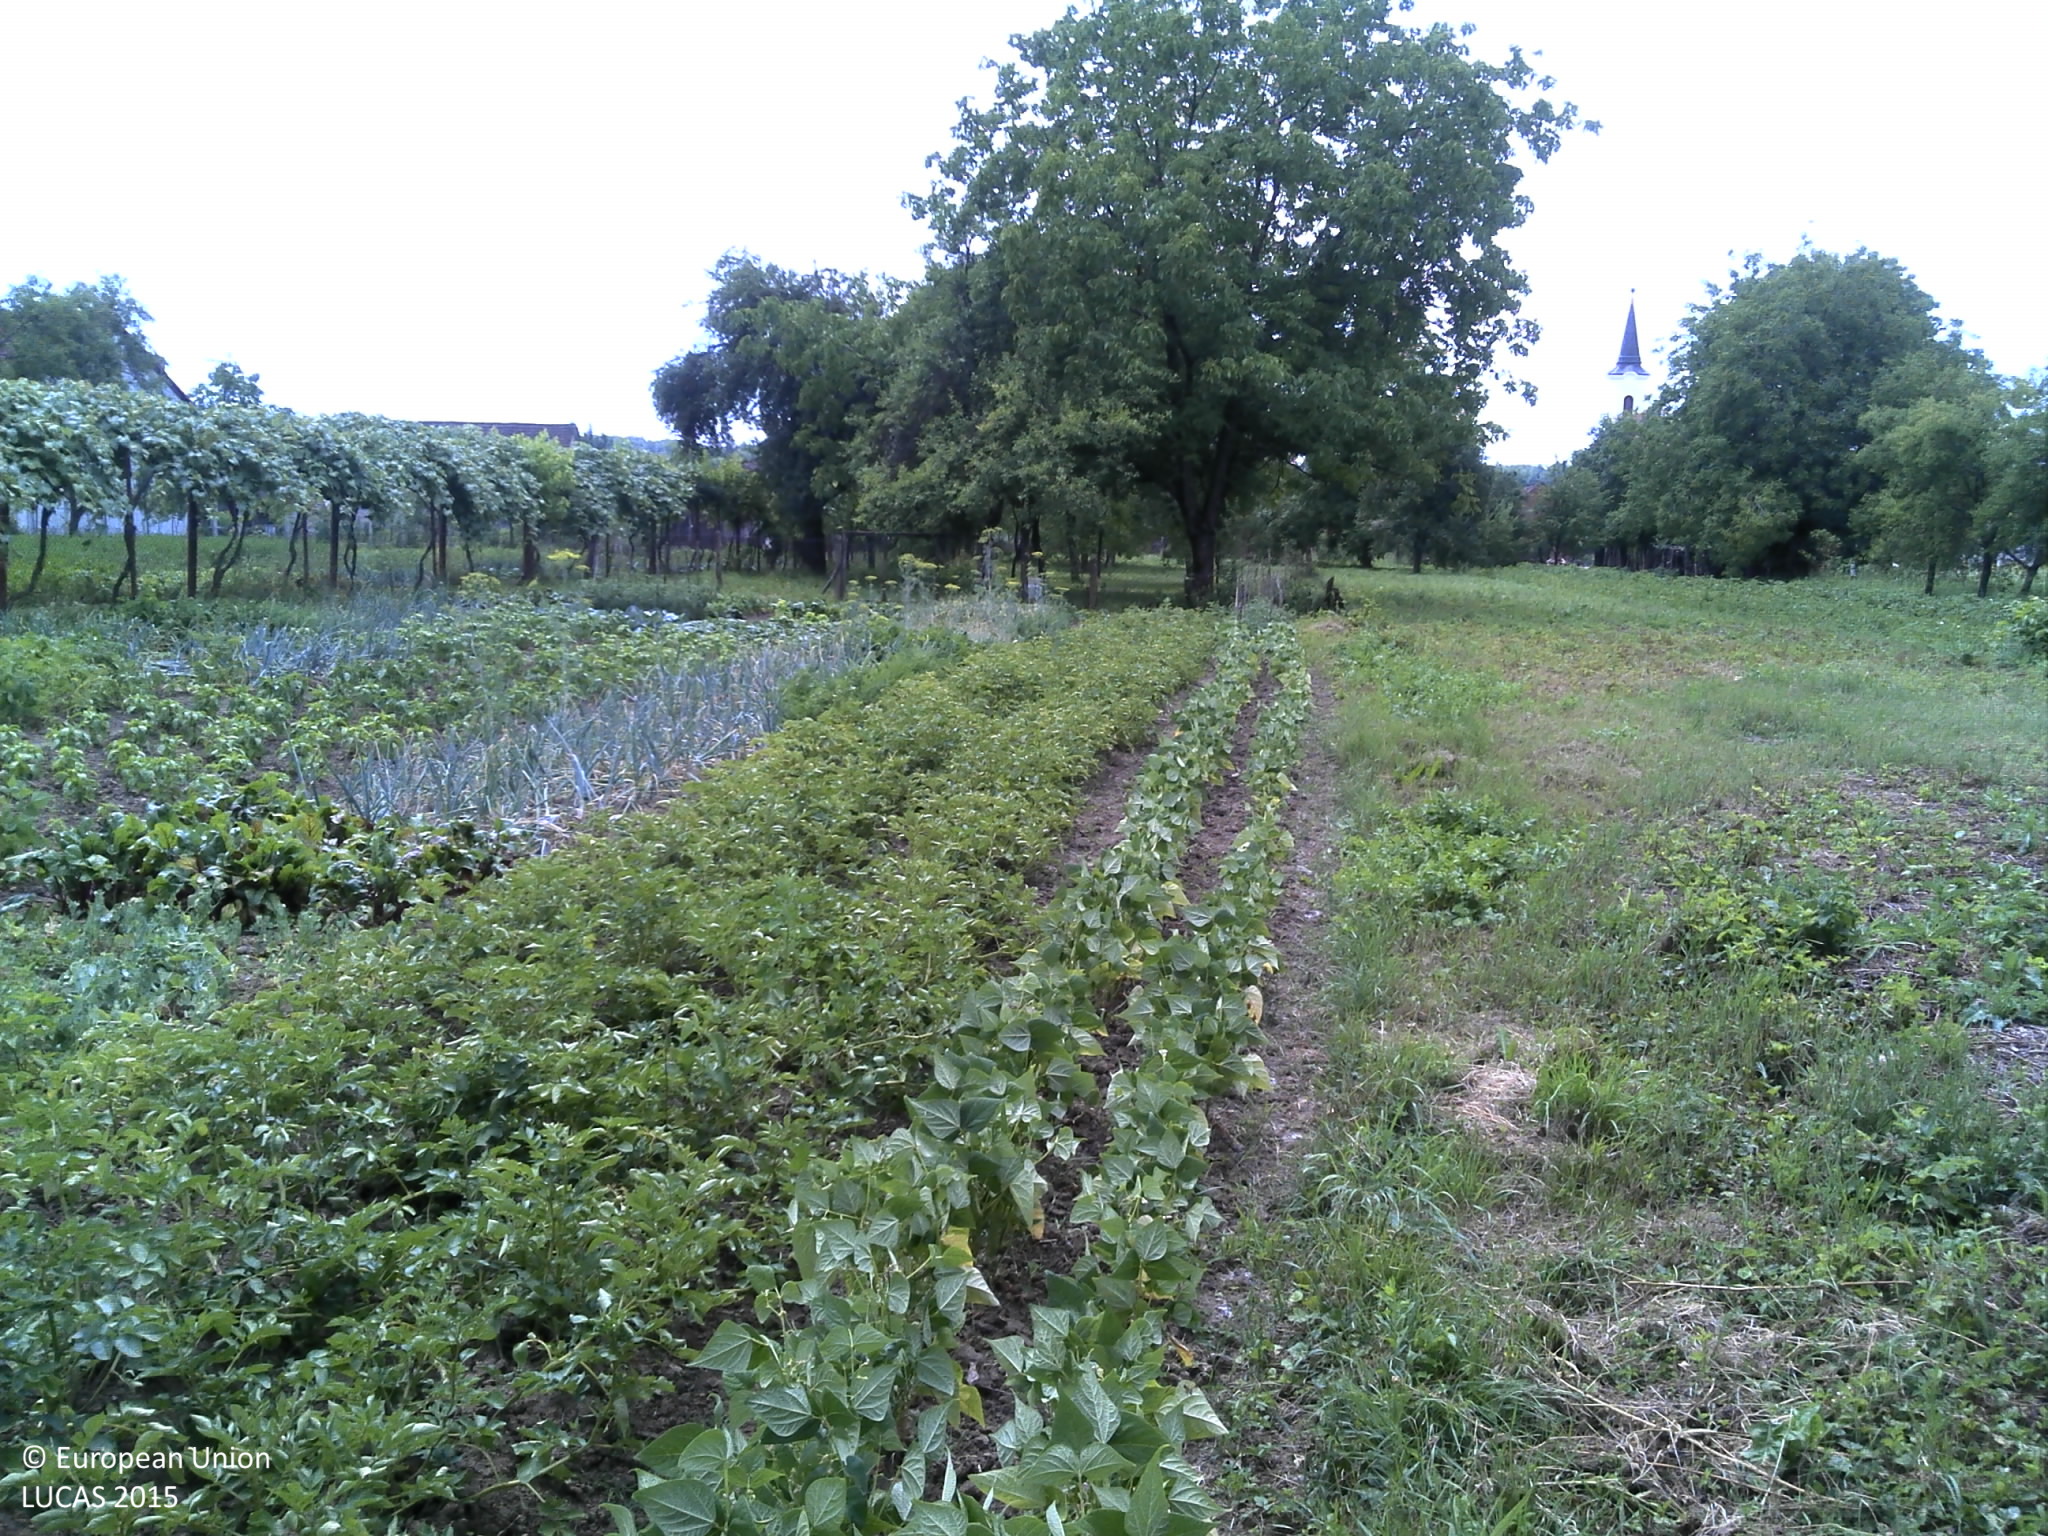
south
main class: Cropland
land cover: Vineyards
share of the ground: 50 - 75 %
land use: Kitchen garden
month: June
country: HR
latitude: 45.0481
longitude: 17.8604
